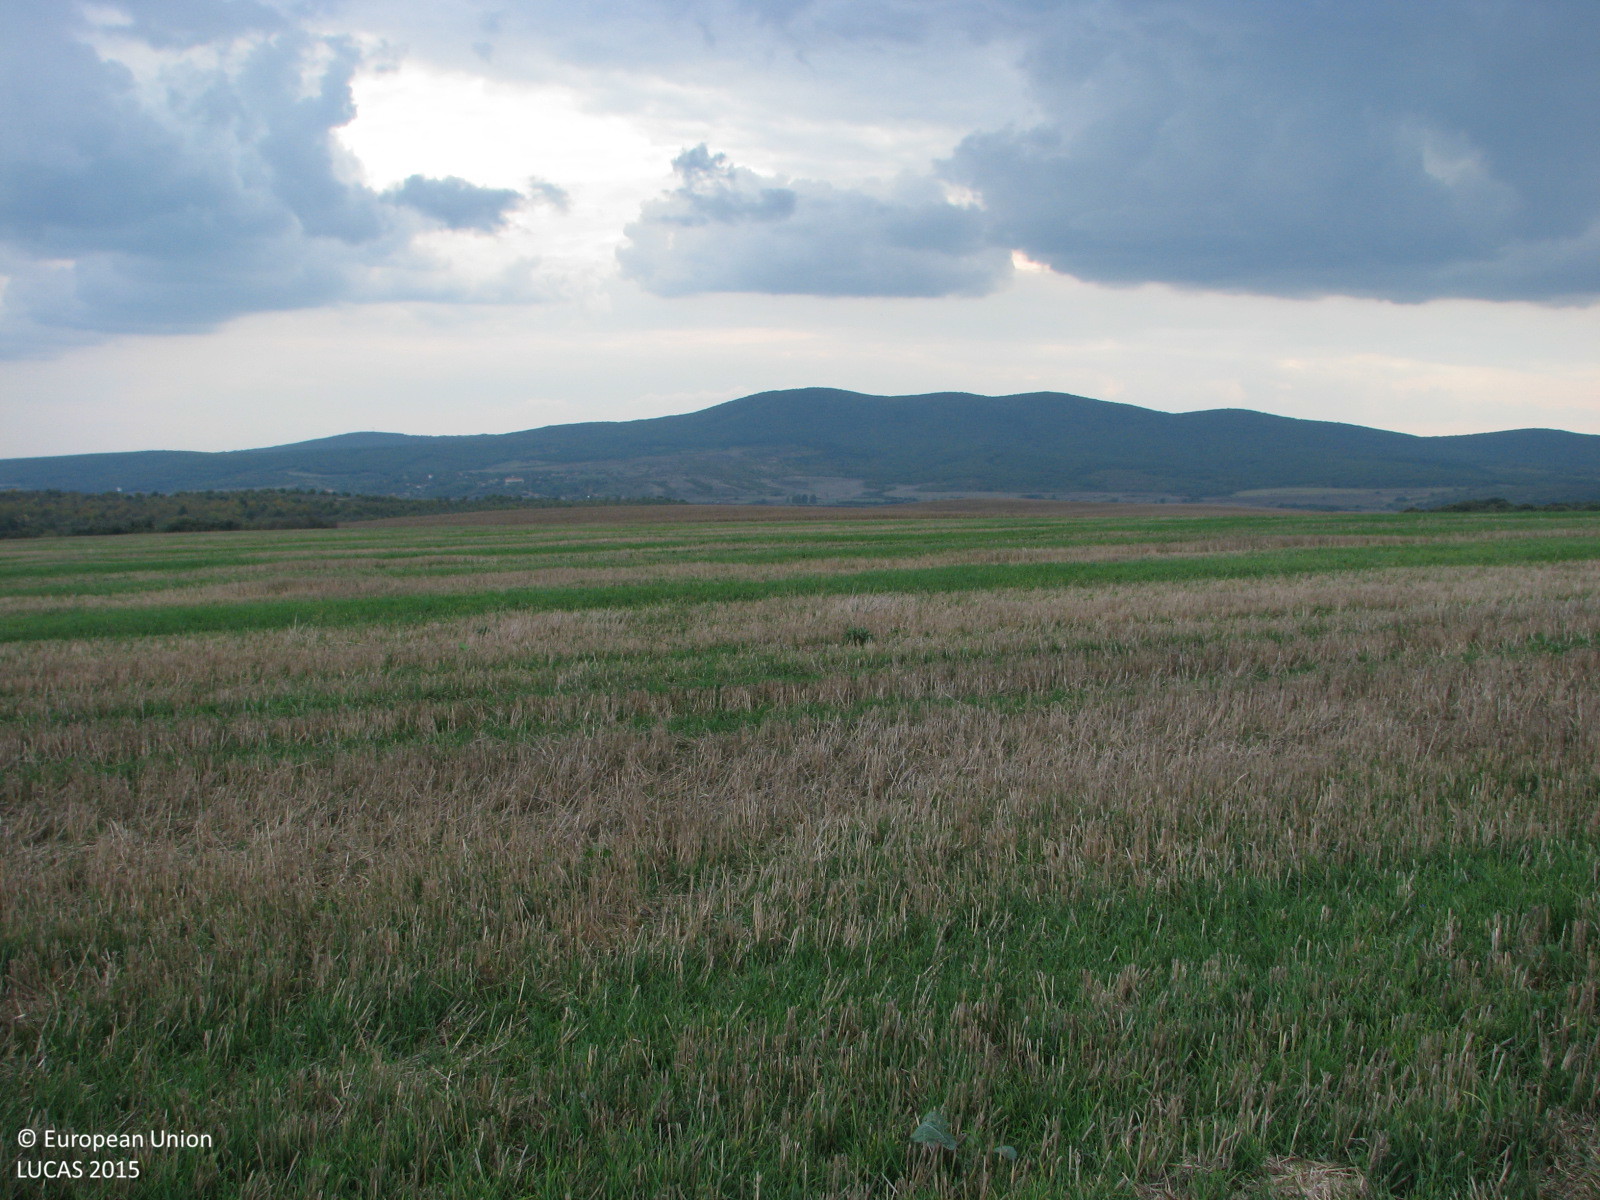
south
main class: Cropland
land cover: Common wheat
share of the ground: > 75 %
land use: Agriculture (excluding fallow land and kitchen gardens)
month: October
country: BG
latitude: 42.2739
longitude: 26.4446
